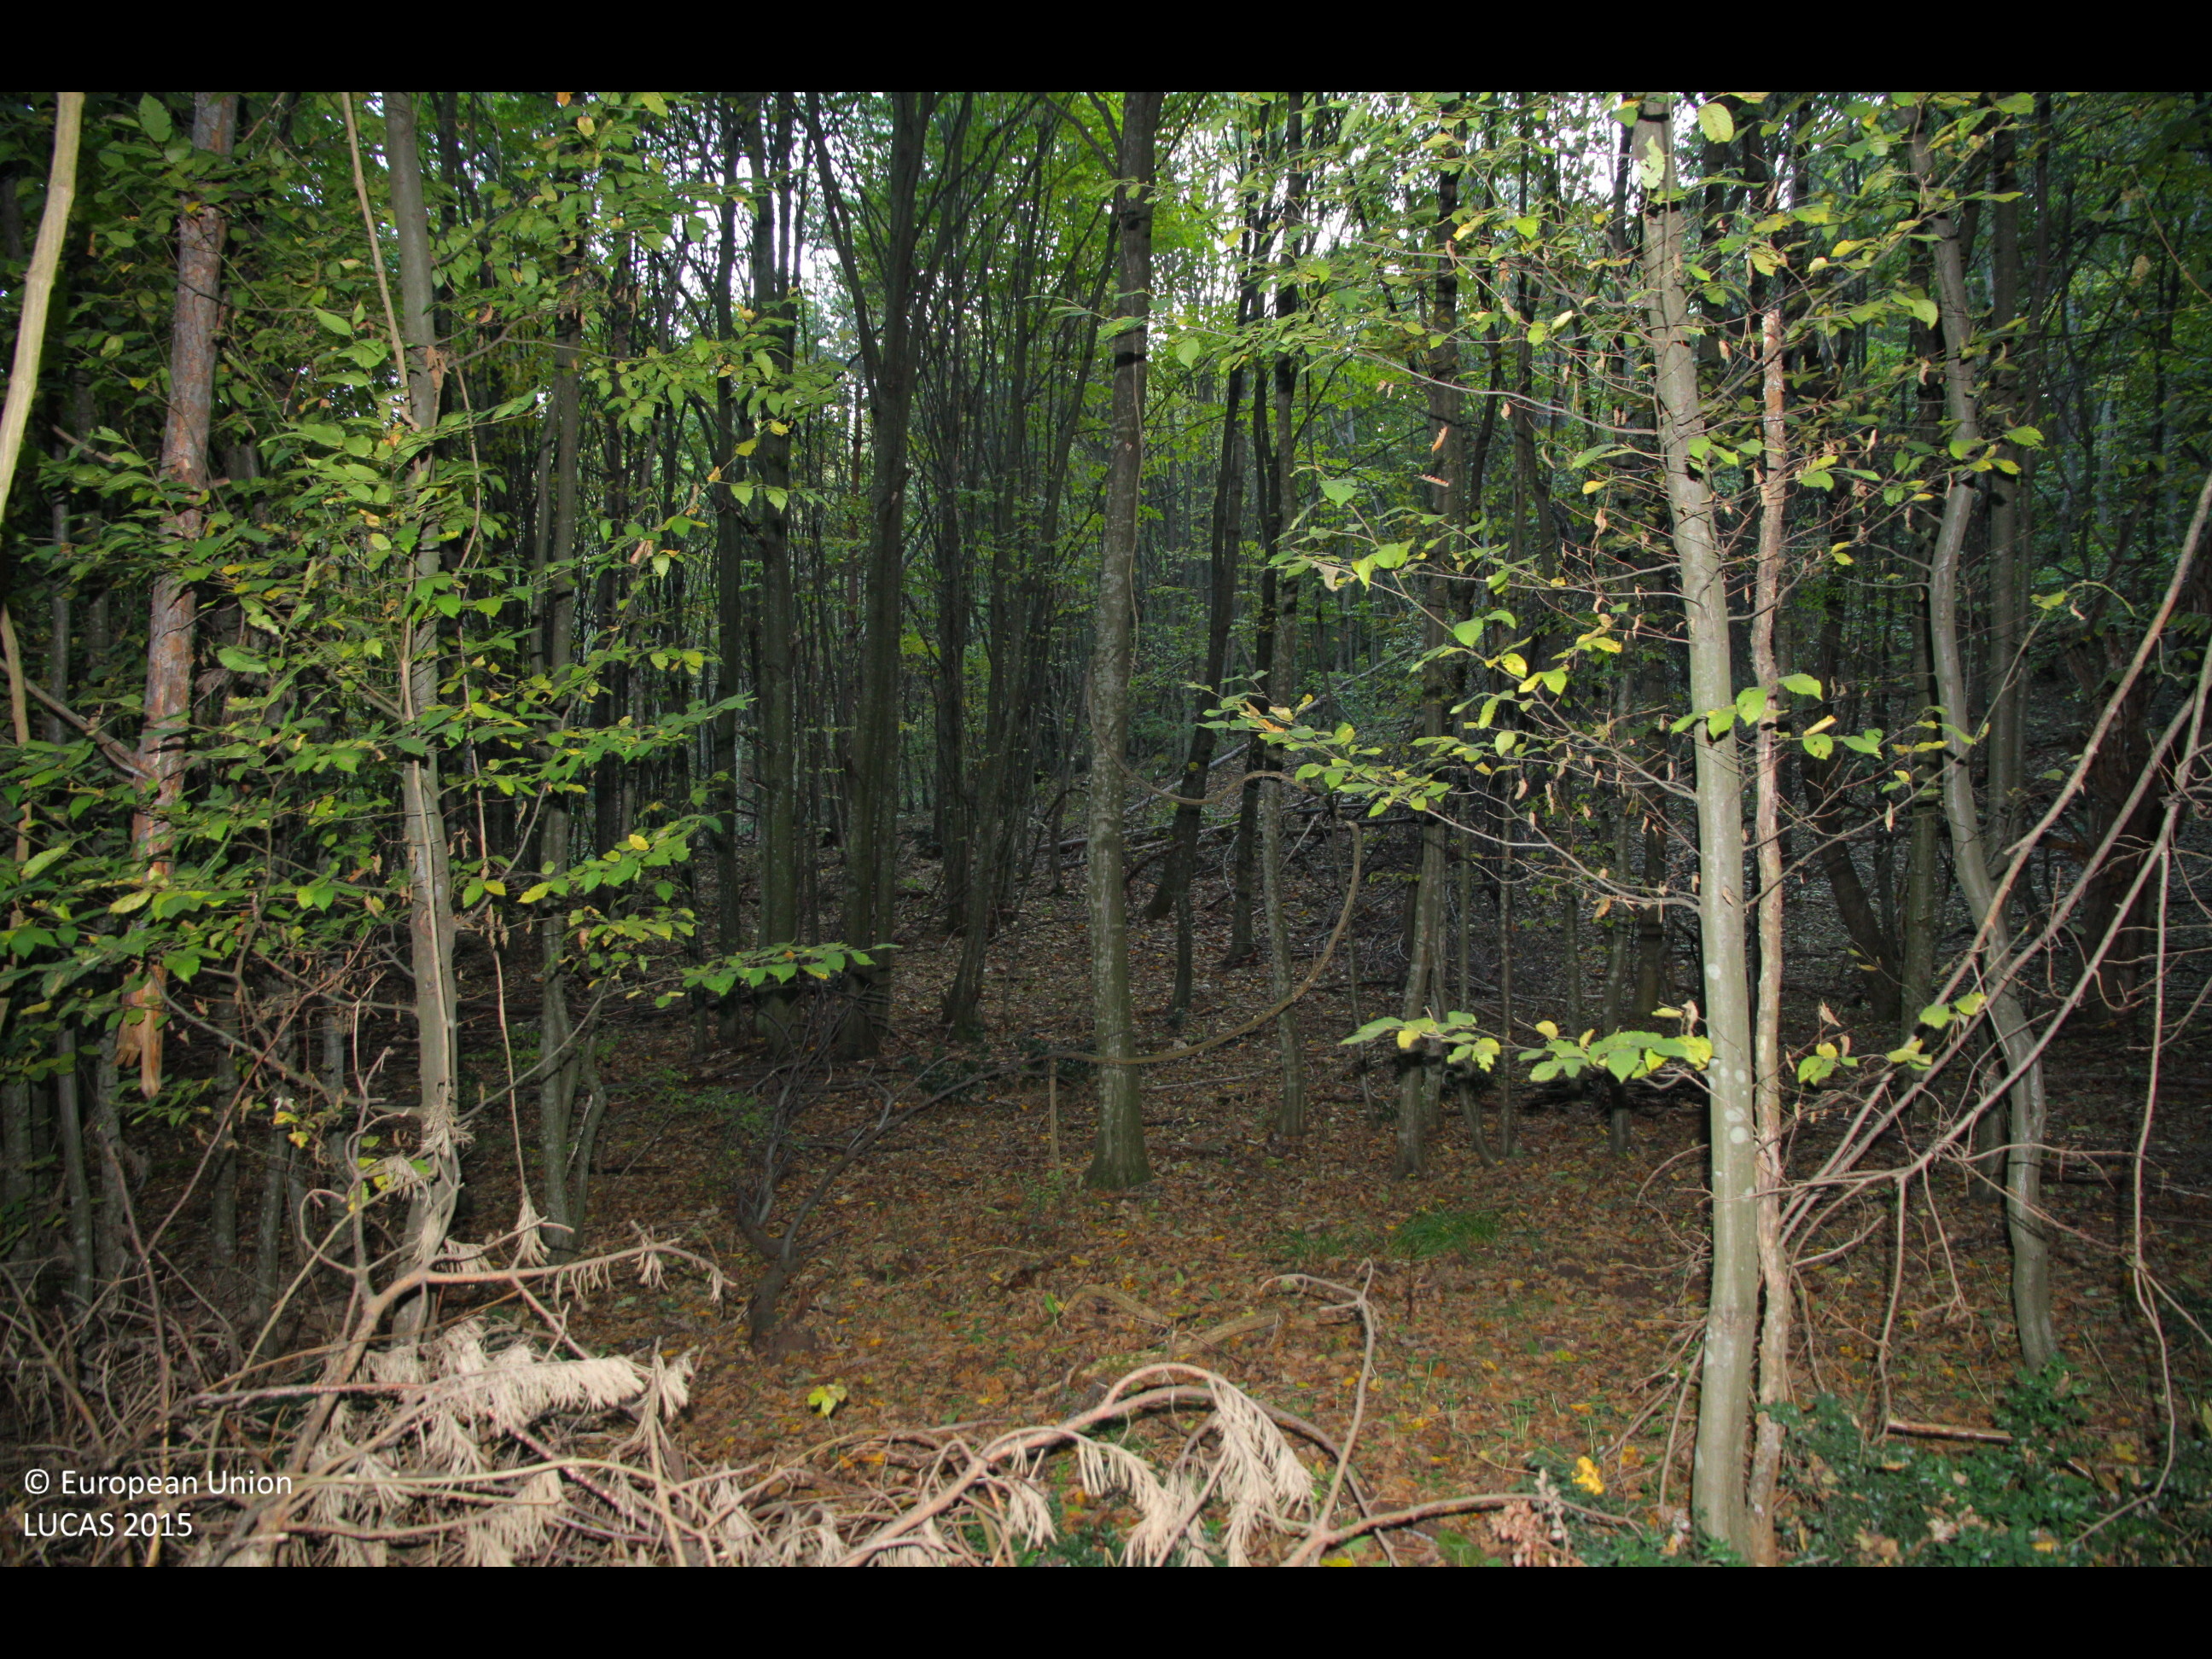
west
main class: Woodland
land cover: Other mixed woodland
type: acidophilous oak and oak-birch forest
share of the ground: > 75 %
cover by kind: broadleaved forest trees 75 %, coniferous forest trees 25 %
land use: Forestry
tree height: > 5 m
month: October
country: BG
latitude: 42.9513
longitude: 27.0134
